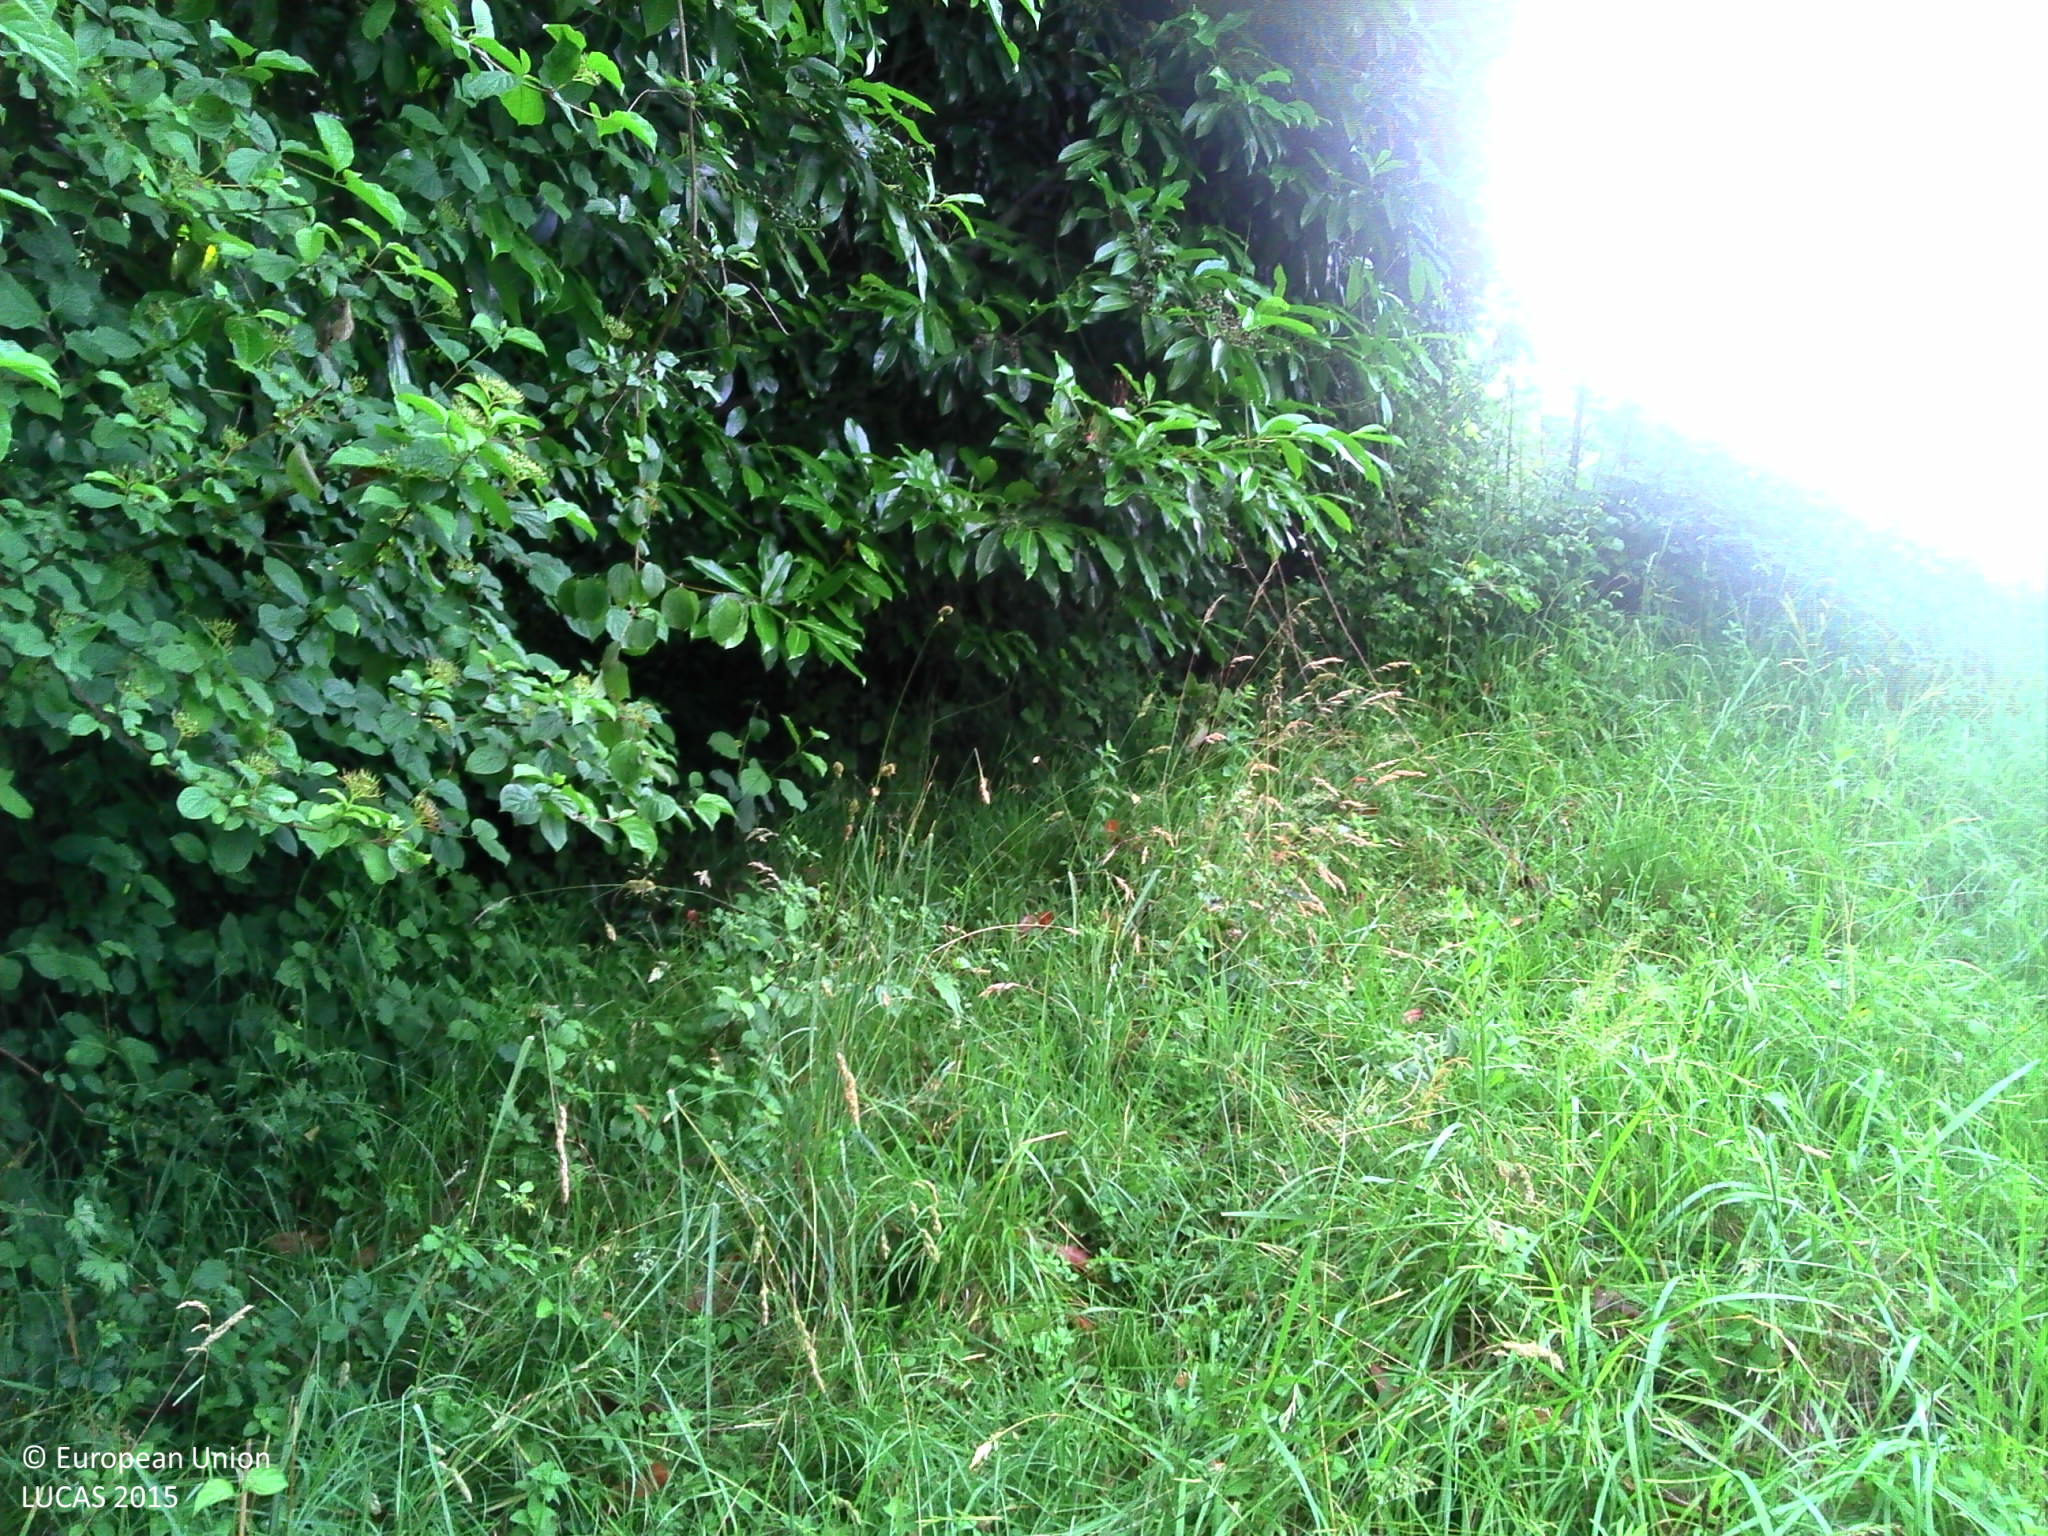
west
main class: Grassland
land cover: Spontaneously vegetated surfaces
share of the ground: > 75 %
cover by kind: herbaceous plants 95 %, shrubs 5 %
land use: Abandoned areas
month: June
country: FR
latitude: 45.5065
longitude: 6.1521
